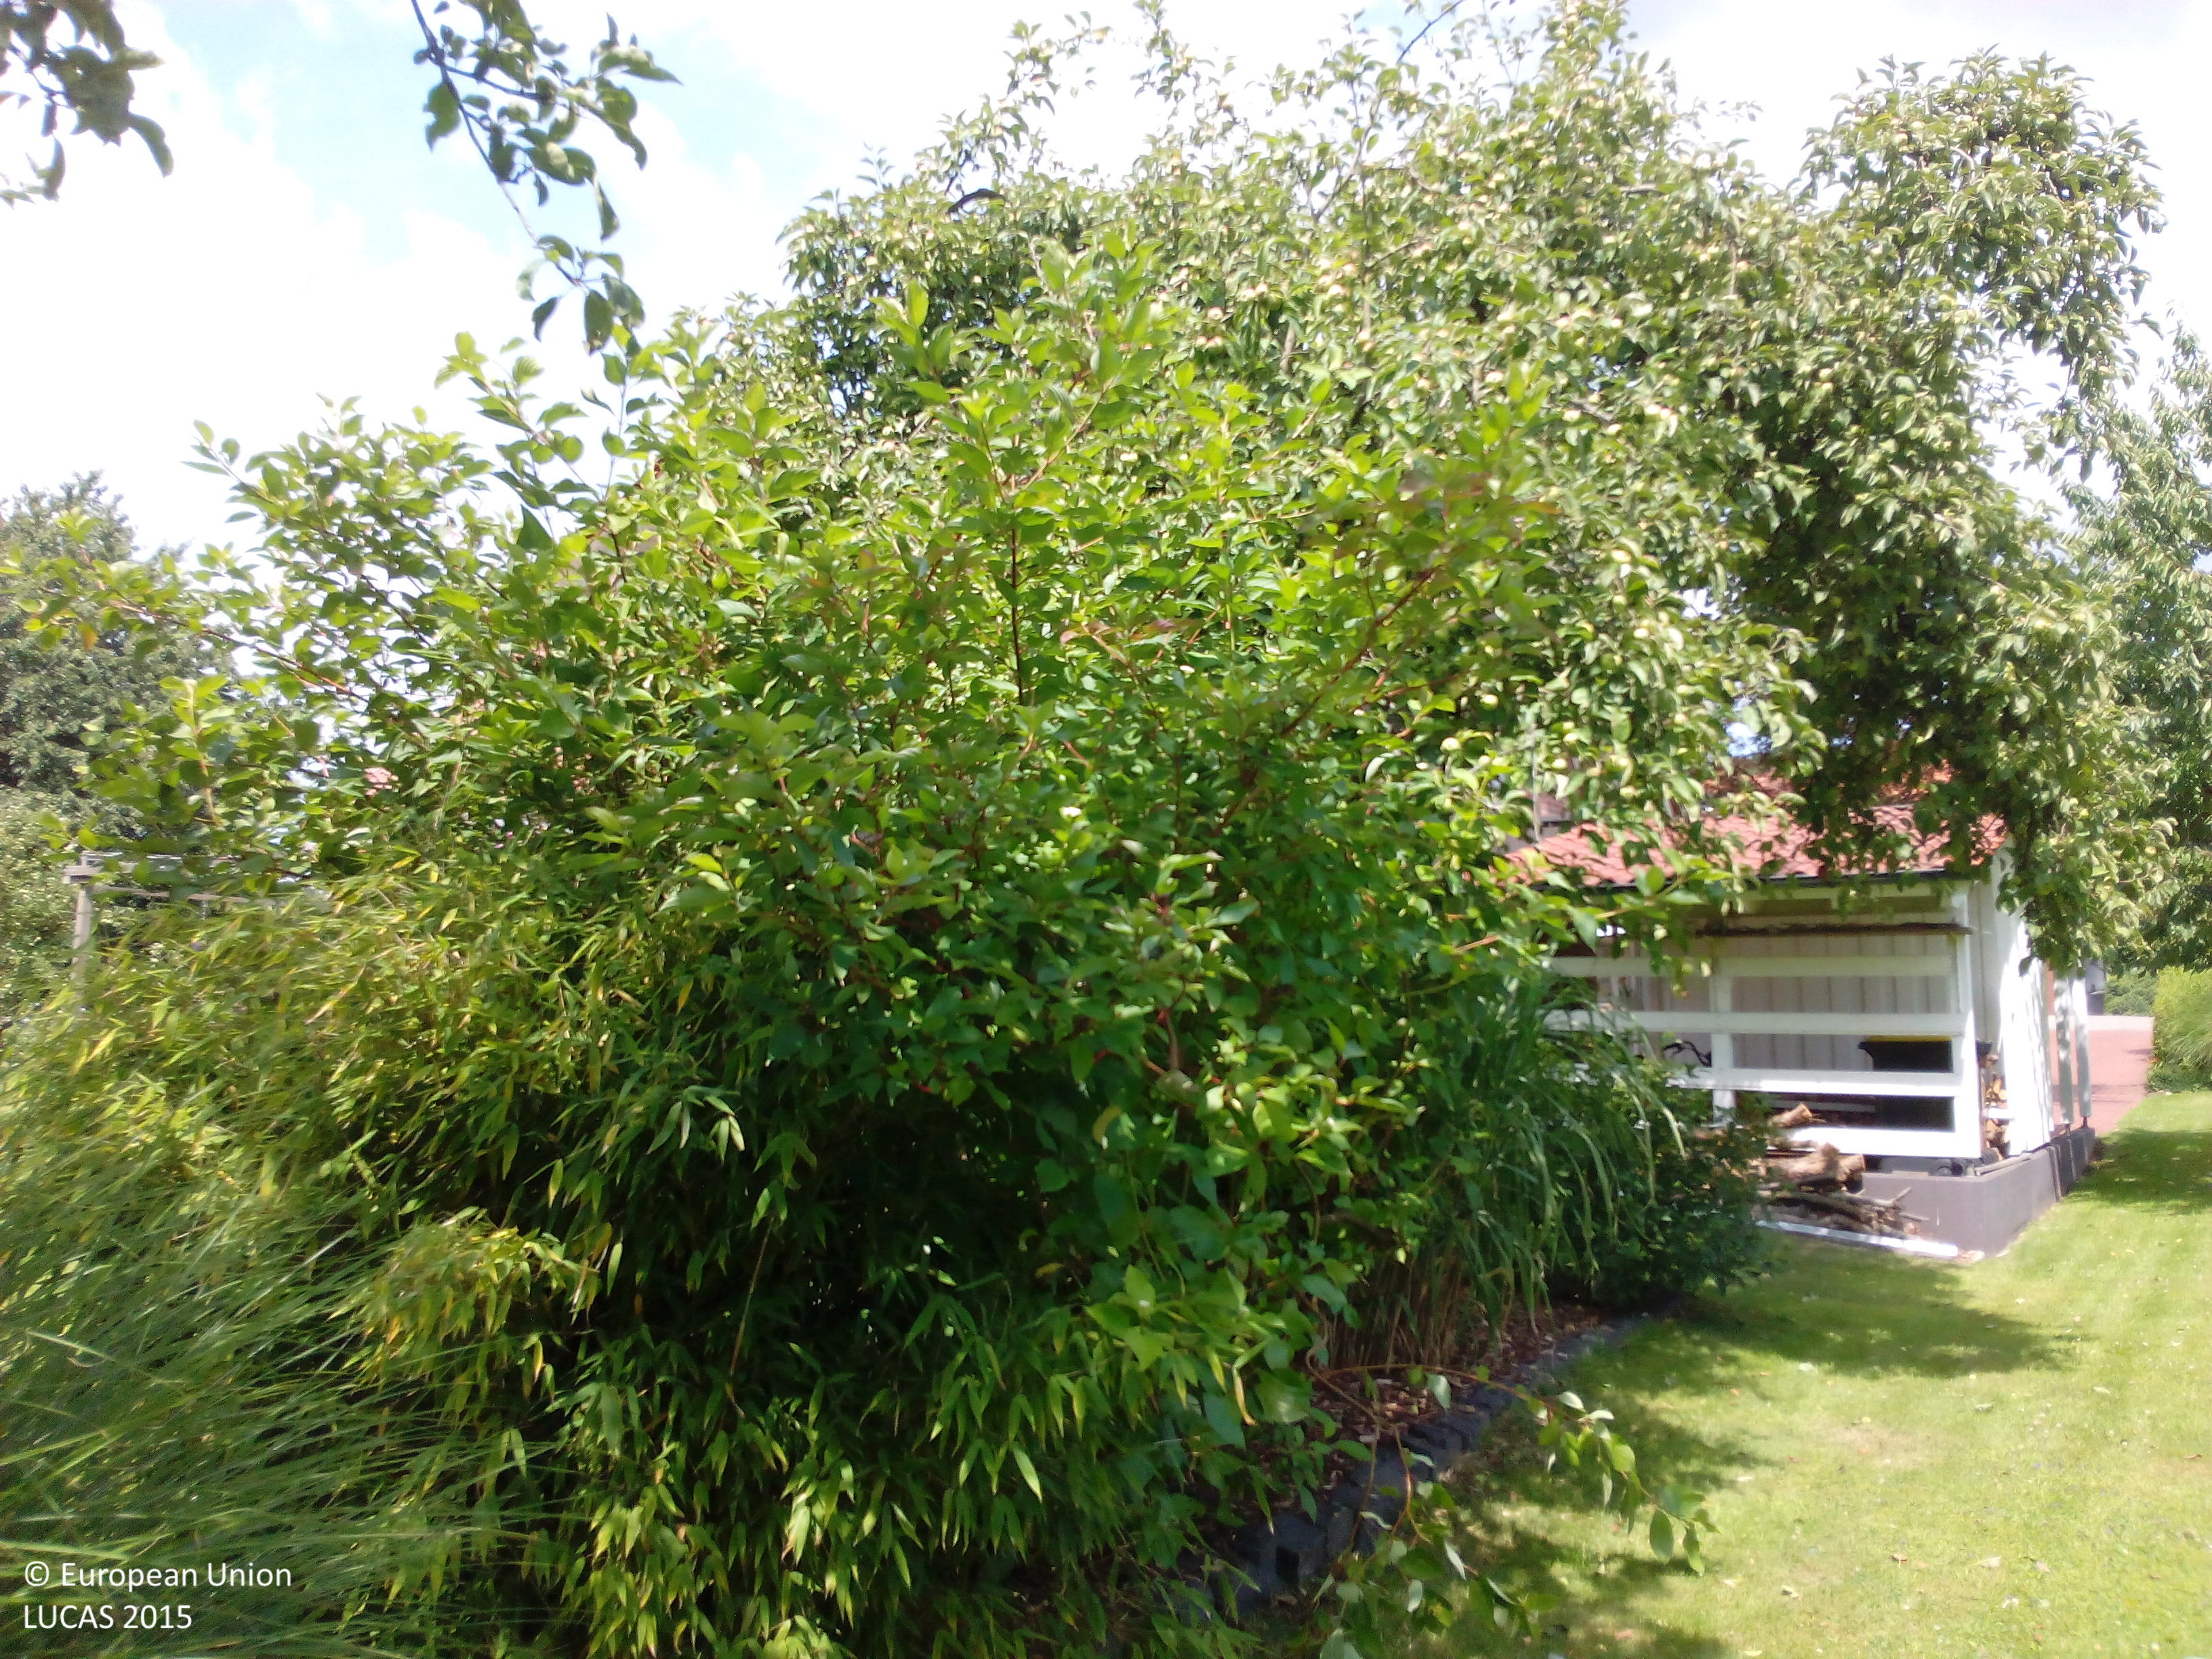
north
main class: Grassland
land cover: Grassland with sparse tree/shrub cover
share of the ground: > 75 %
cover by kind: herbaceous plants 95 %, broadleaved forest trees 5 %
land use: Residential
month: July
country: DE
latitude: 52.1983
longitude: 7.9668
